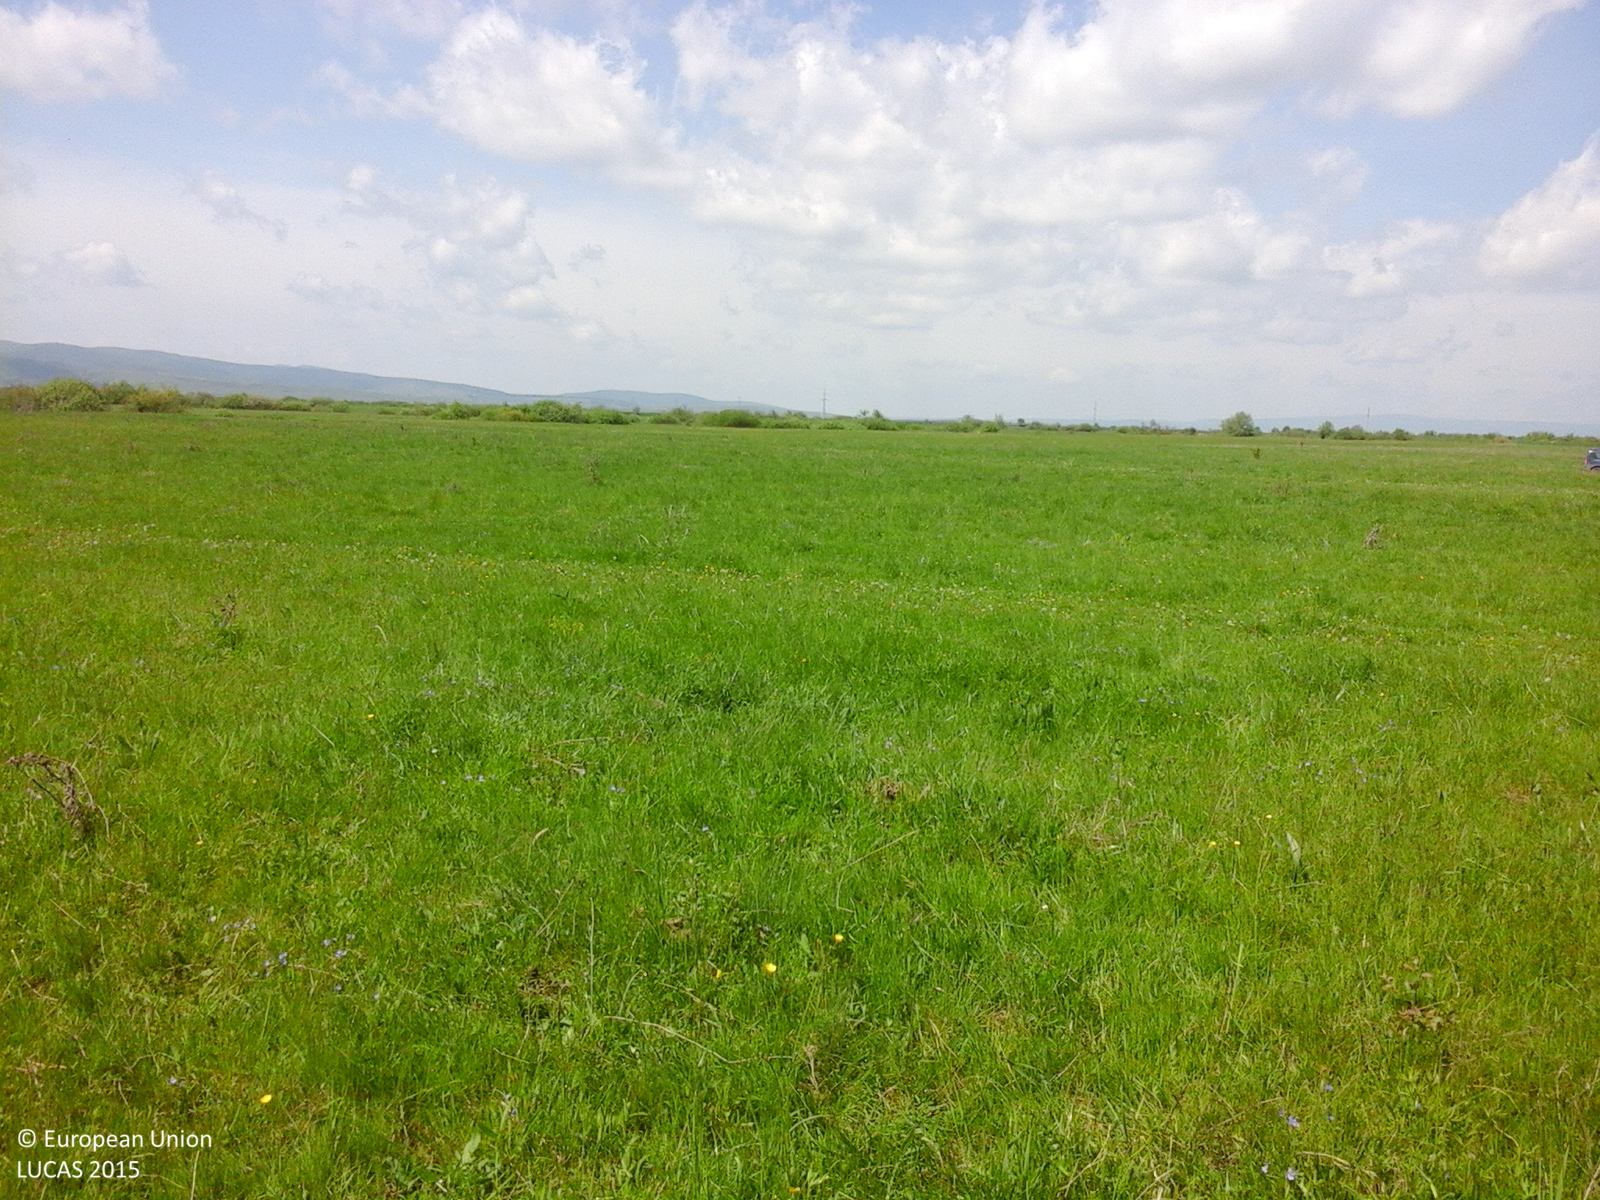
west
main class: Grassland
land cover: Grassland without tree/shrub cover
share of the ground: > 75 %
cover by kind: herbaceous plants 95 %, consolidated bare surface 5 %
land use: Agriculture (excluding fallow land and kitchen gardens)
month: May
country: RO
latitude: 45.8164
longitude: 26.1157
